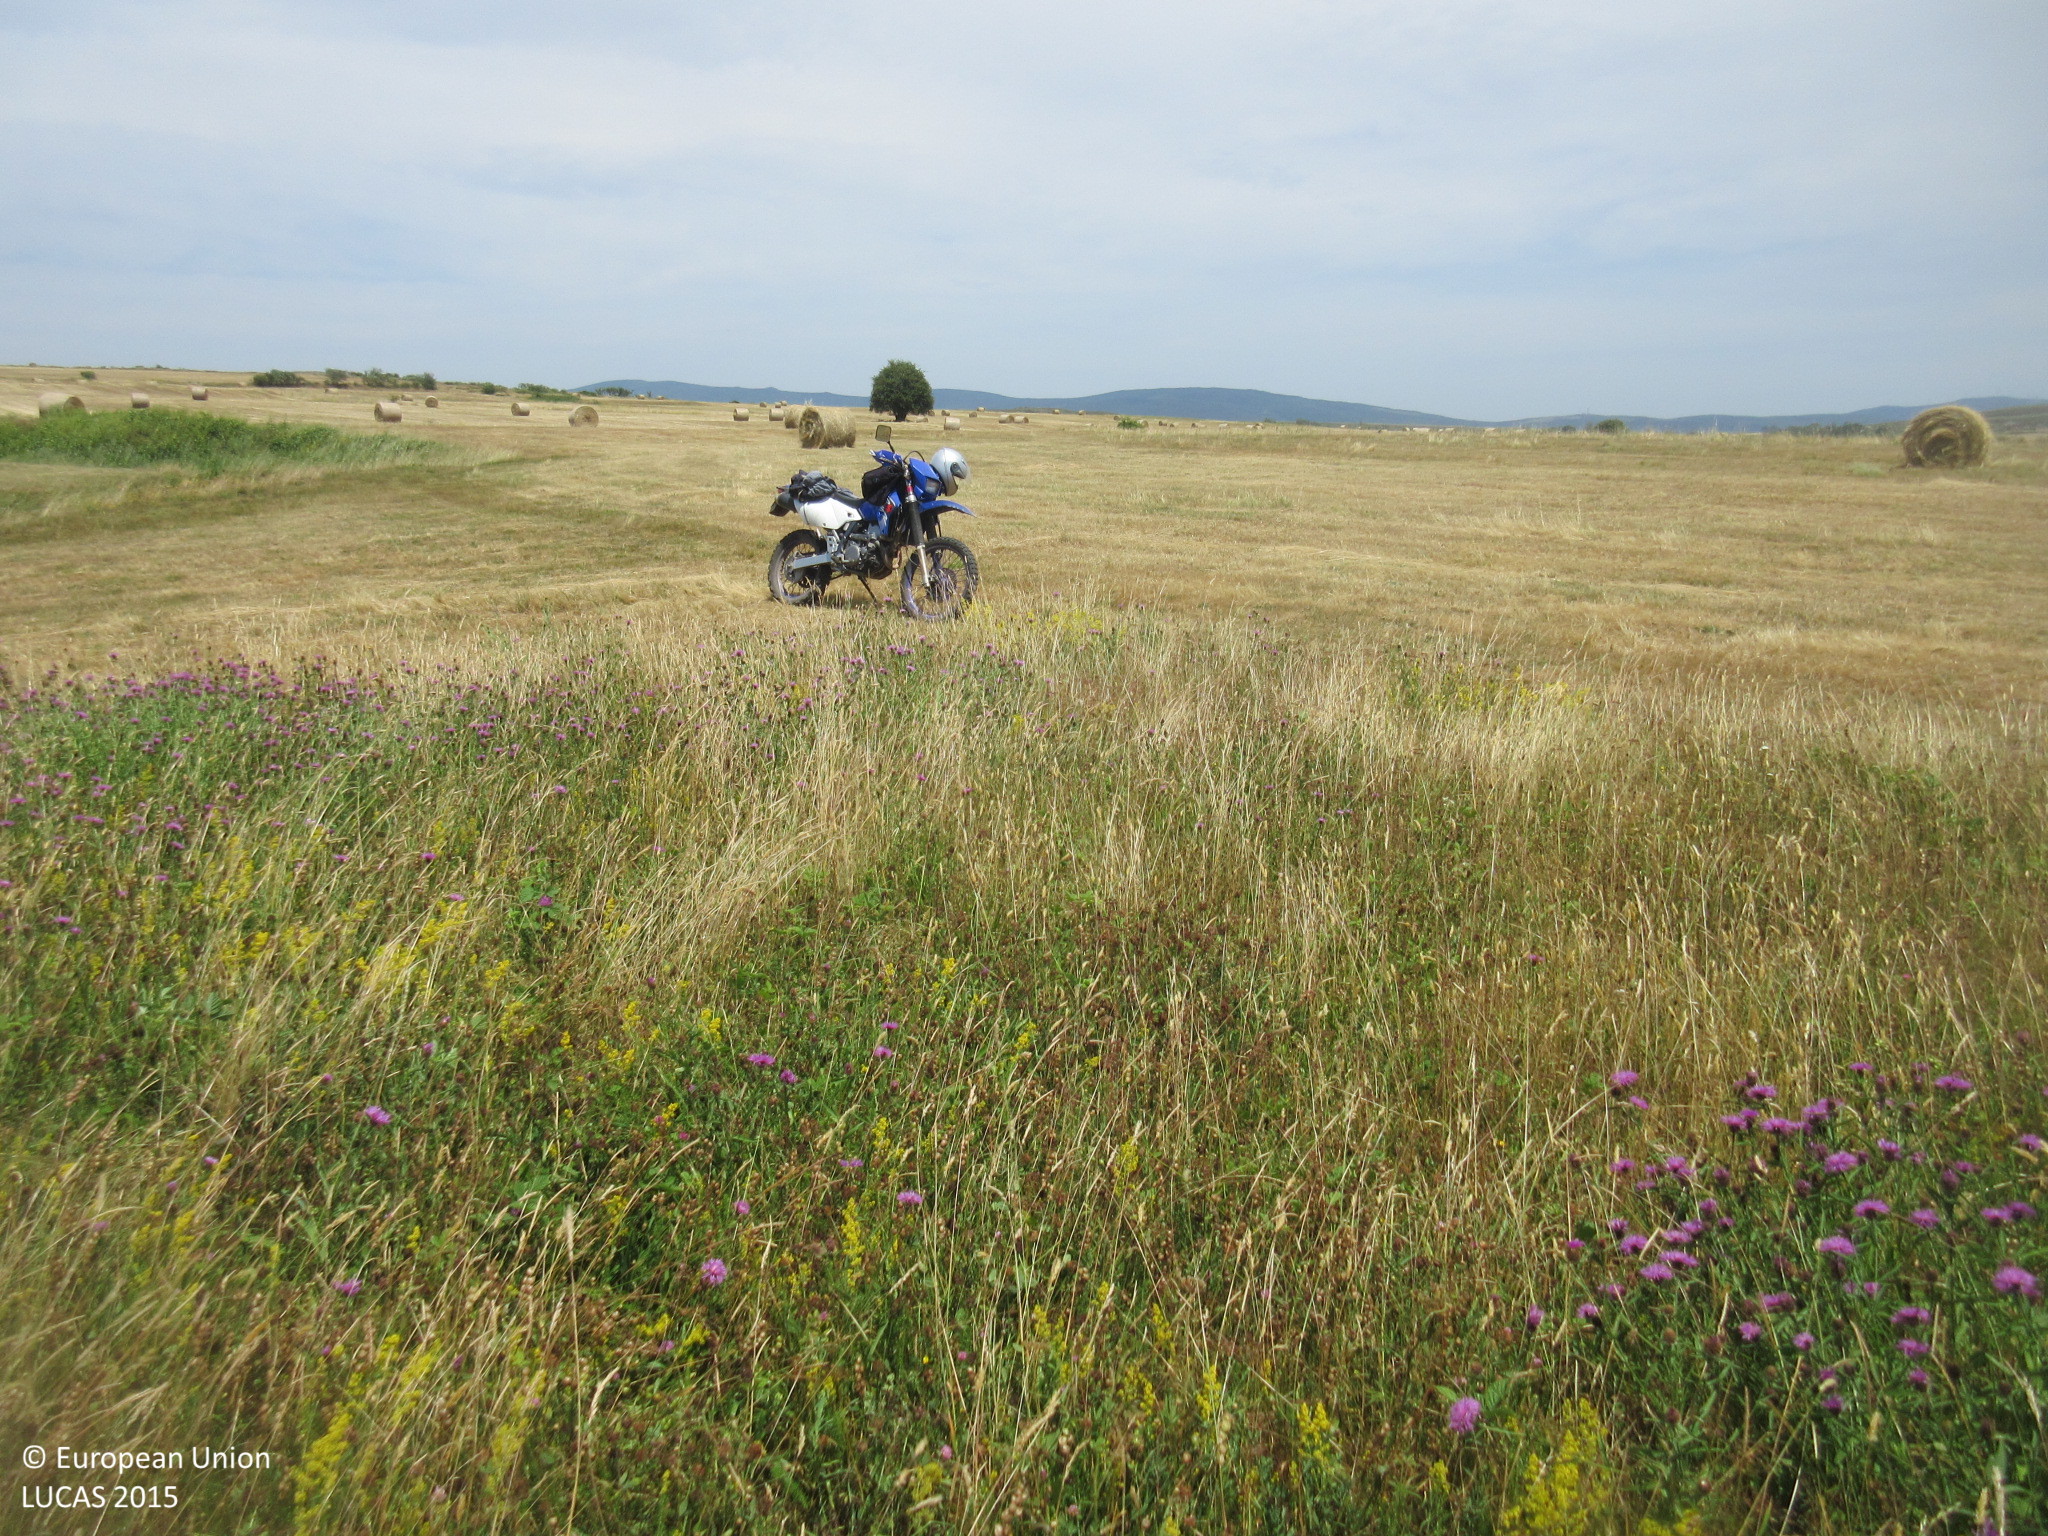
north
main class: Grassland
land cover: Spontaneously vegetated surfaces
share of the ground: > 75 %
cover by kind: herbaceous plants 100 %
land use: Agriculture (excluding fallow land and kitchen gardens)
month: July
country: ES
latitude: 42.9658
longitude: -3.9370
